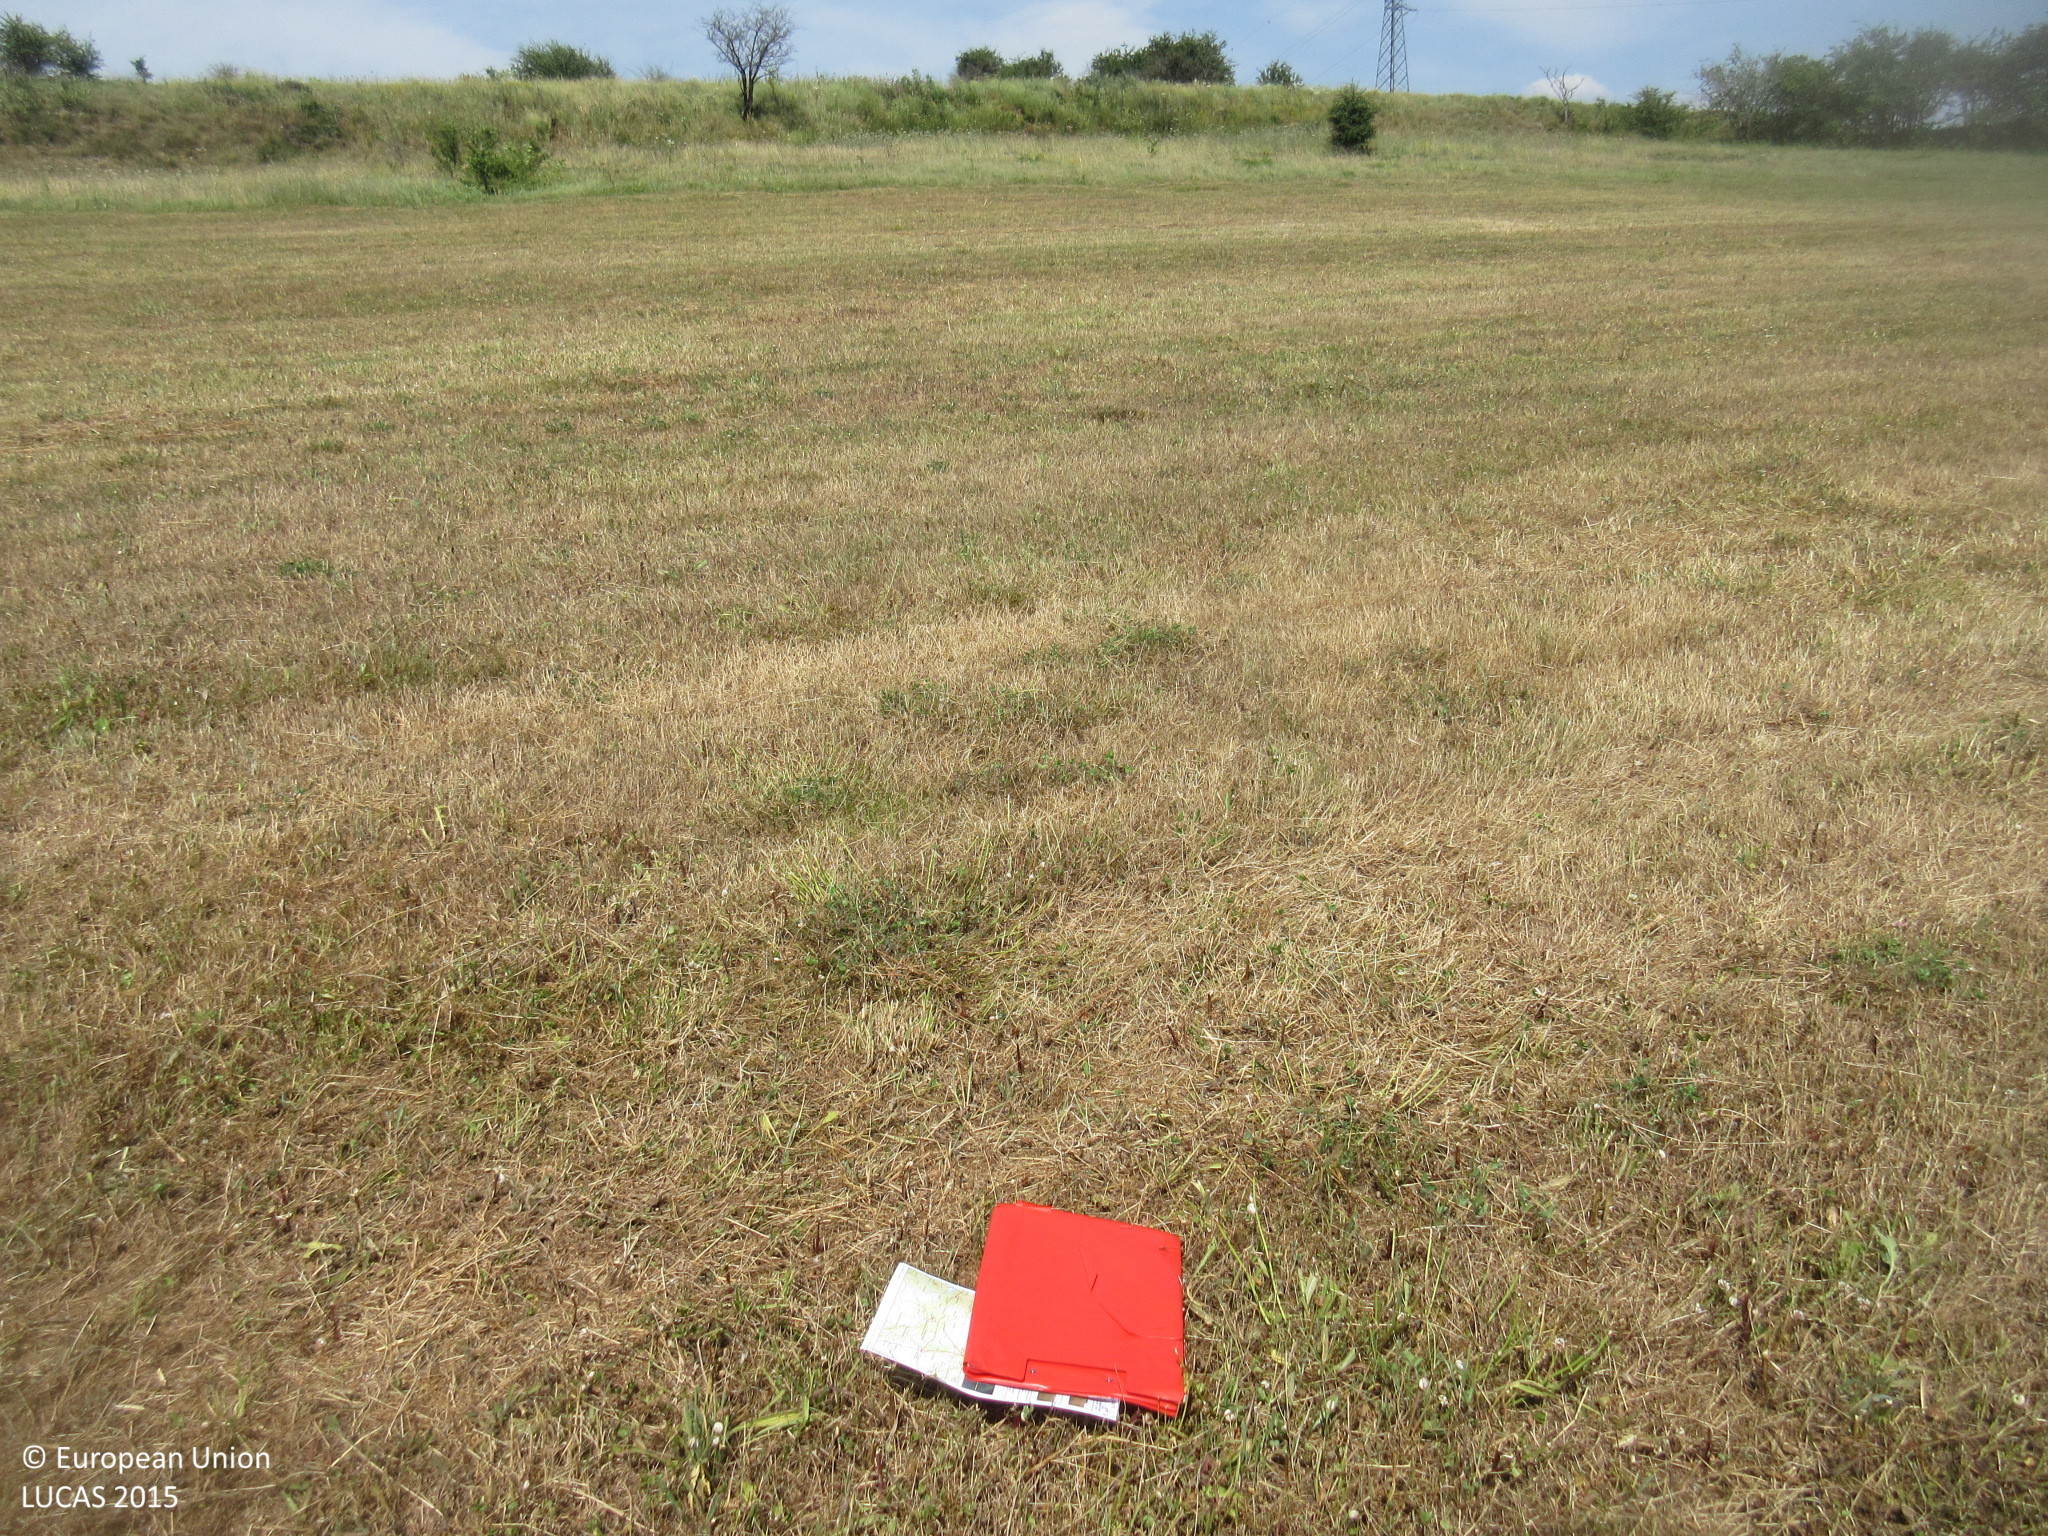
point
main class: Grassland
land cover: Grassland without tree/shrub cover
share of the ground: > 75 %
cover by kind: herbaceous plants 100 %
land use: Agriculture (excluding fallow land and kitchen gardens)
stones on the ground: 25 - 50 %
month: July
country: ES
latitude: 42.9725
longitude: -3.8887
